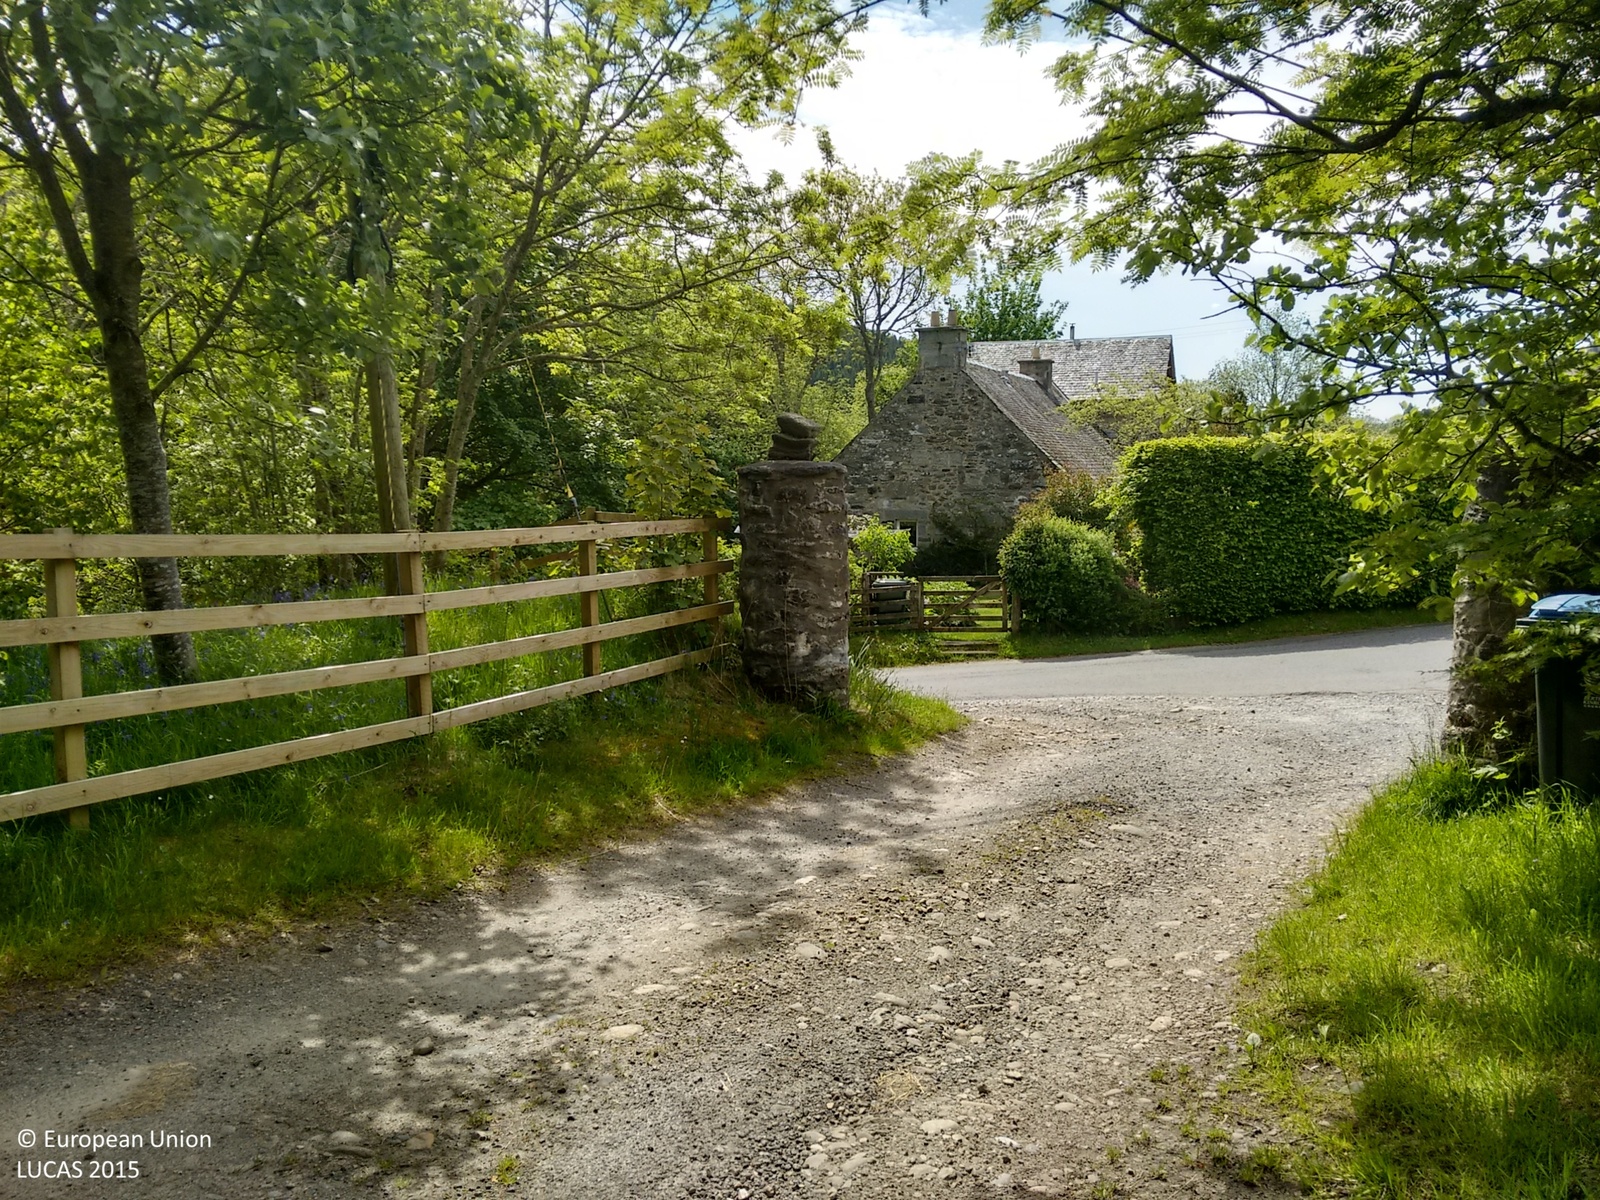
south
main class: Grassland
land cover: Grassland without tree/shrub cover
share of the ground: > 75 %
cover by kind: herbaceous plants 100 %
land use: Agriculture (excluding fallow land and kitchen gardens)
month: June
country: GB
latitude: 56.5951
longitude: -4.0761
